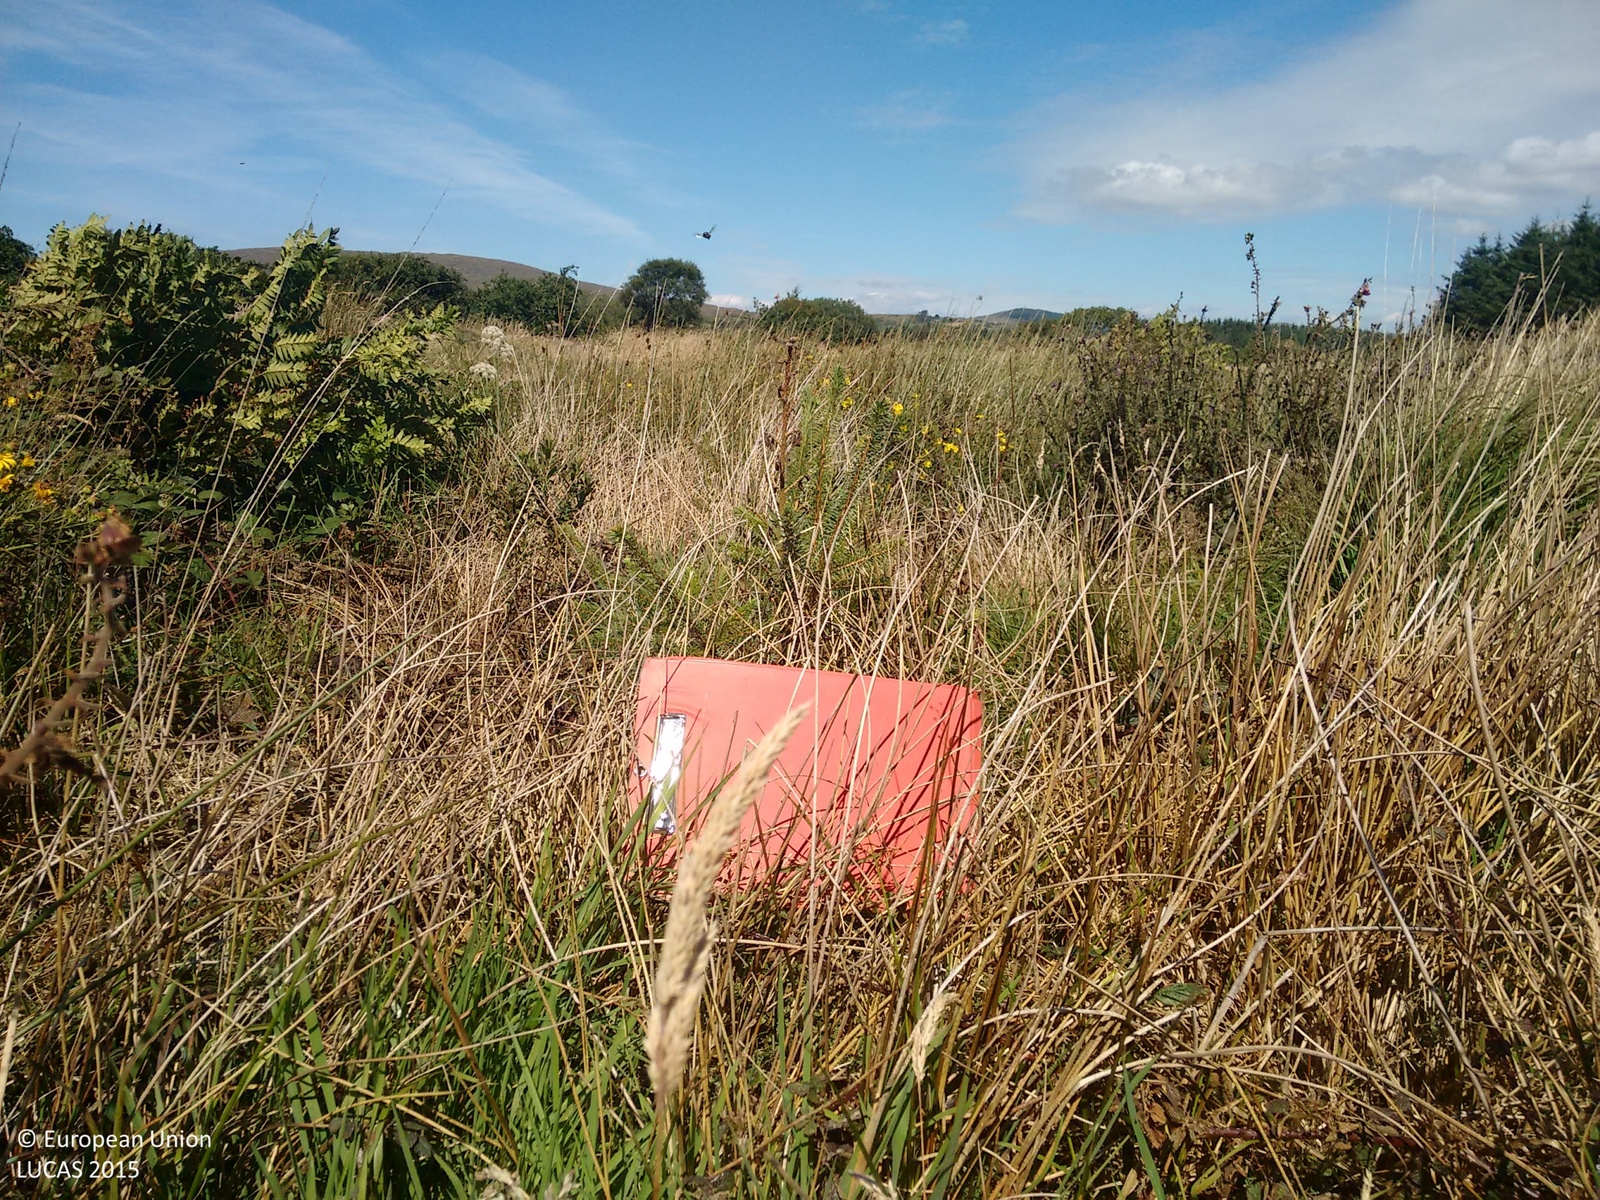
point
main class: Woodland
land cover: Spruce dominated coniferous woodland
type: exotic forest
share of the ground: > 75 %
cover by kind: coniferous forest trees 50 %, herbaceous plants 50 %
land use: Forestry
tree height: < 5 m
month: August
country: IE
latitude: 51.5664
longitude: -9.5219
